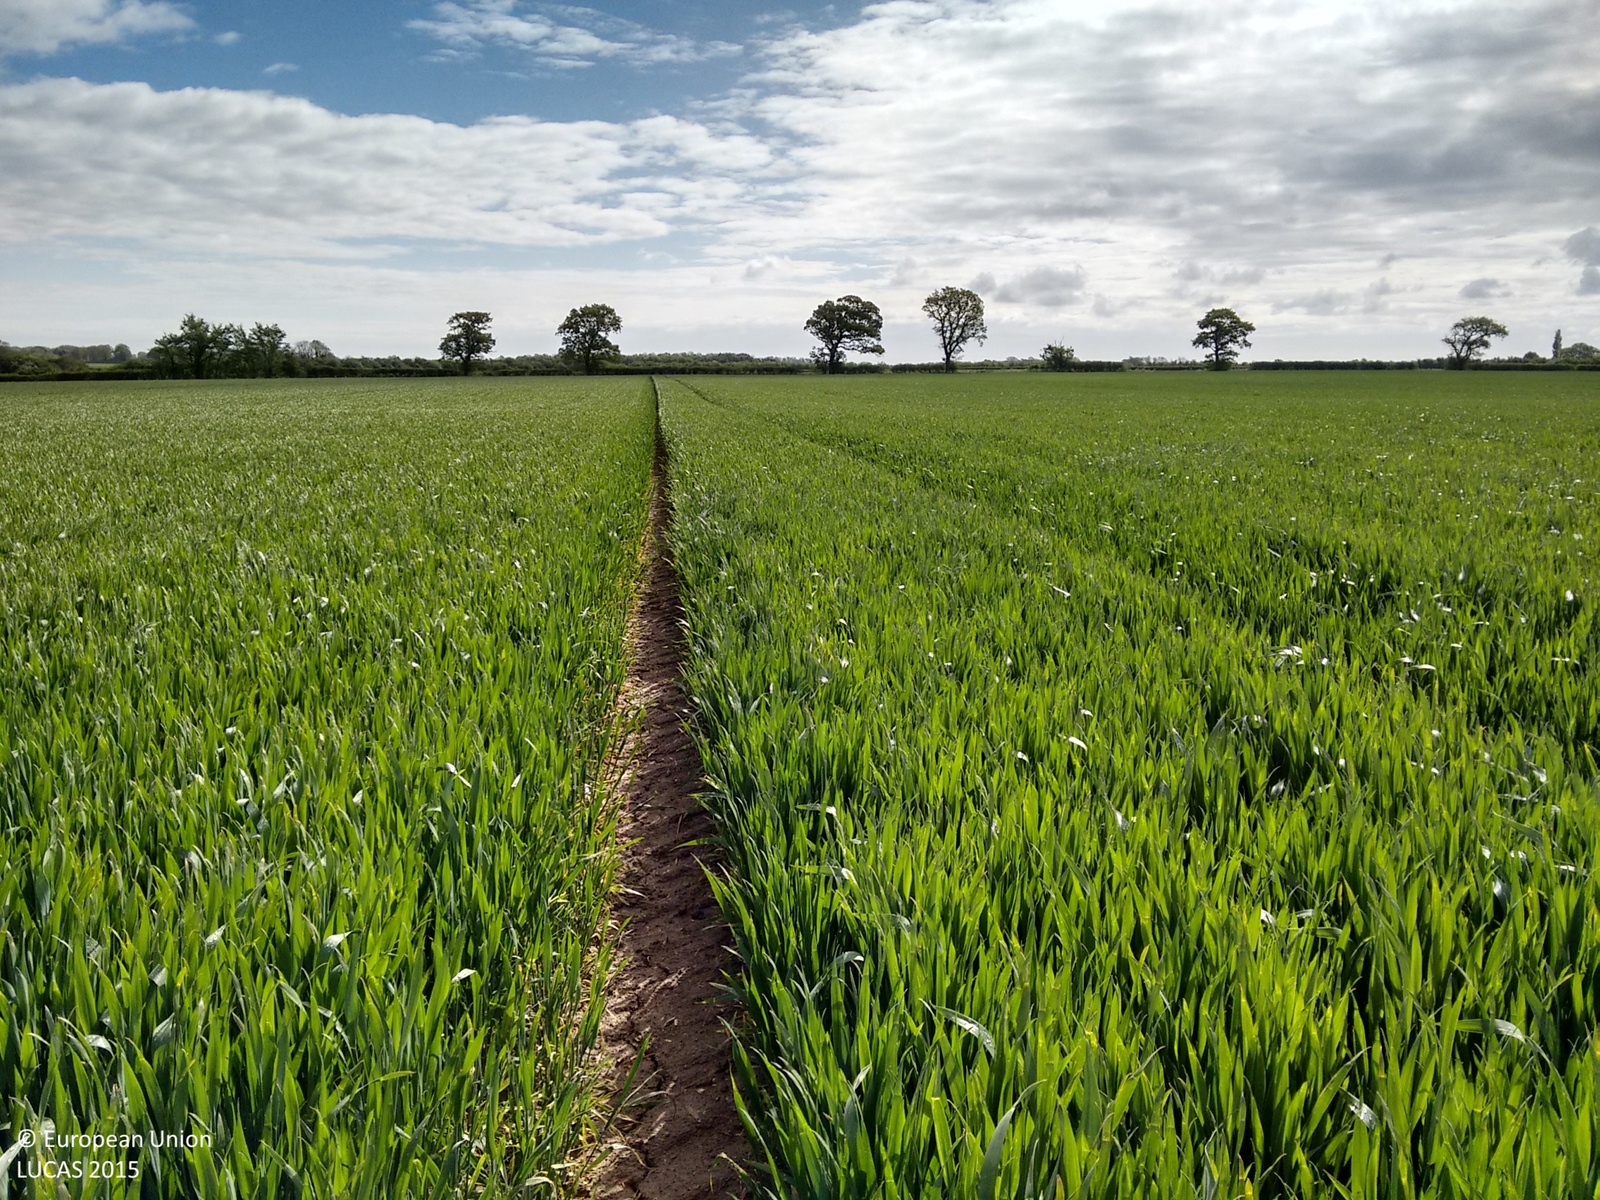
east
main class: Cropland
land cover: Common wheat
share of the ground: > 75 %
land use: Agriculture (excluding fallow land and kitchen gardens)
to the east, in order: Common wheat; Grass margins; Managed hedges; Grass margins; Barley
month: May
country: GB
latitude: 53.4721
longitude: -0.0508
